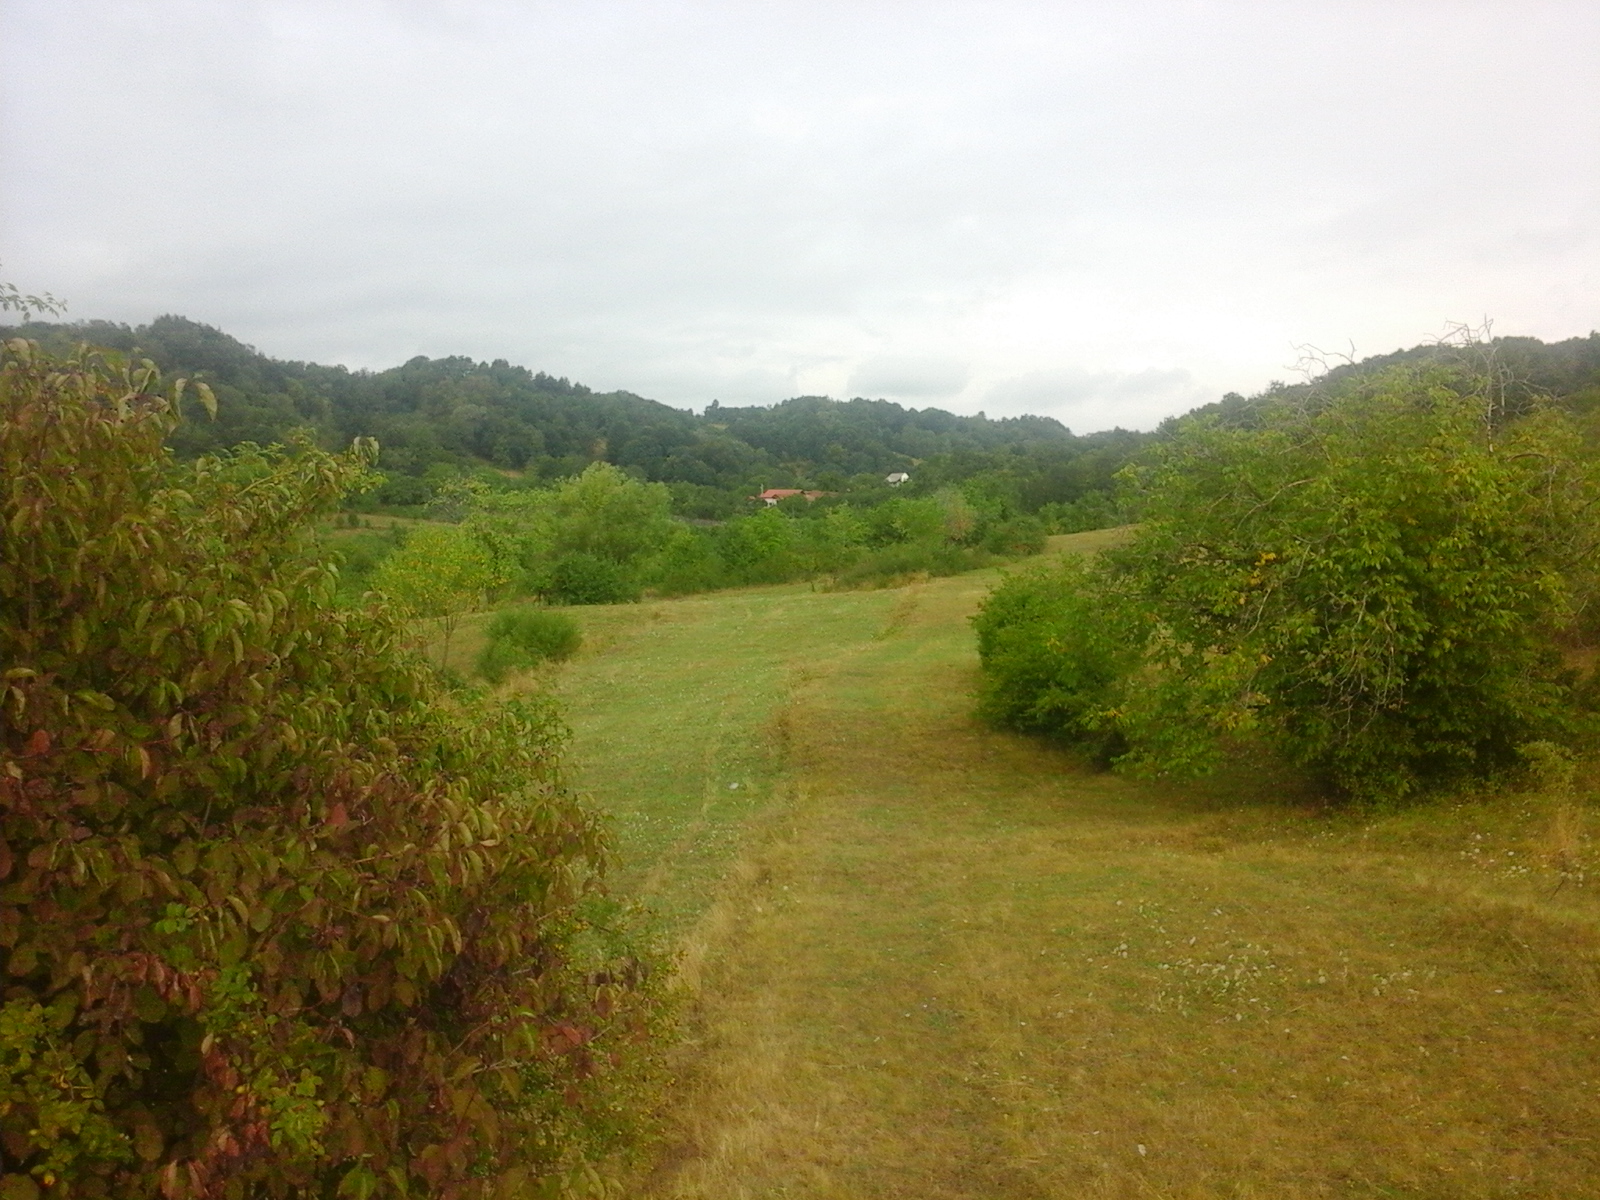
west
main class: Grassland
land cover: Grassland with sparse tree/shrub cover
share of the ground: > 75 %
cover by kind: herbaceous plants 95 %, broadleaved forest trees 5 %
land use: Agriculture (excluding fallow land and kitchen gardens)
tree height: < 5 m
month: August
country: RO
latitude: 44.8863
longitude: 22.7949
